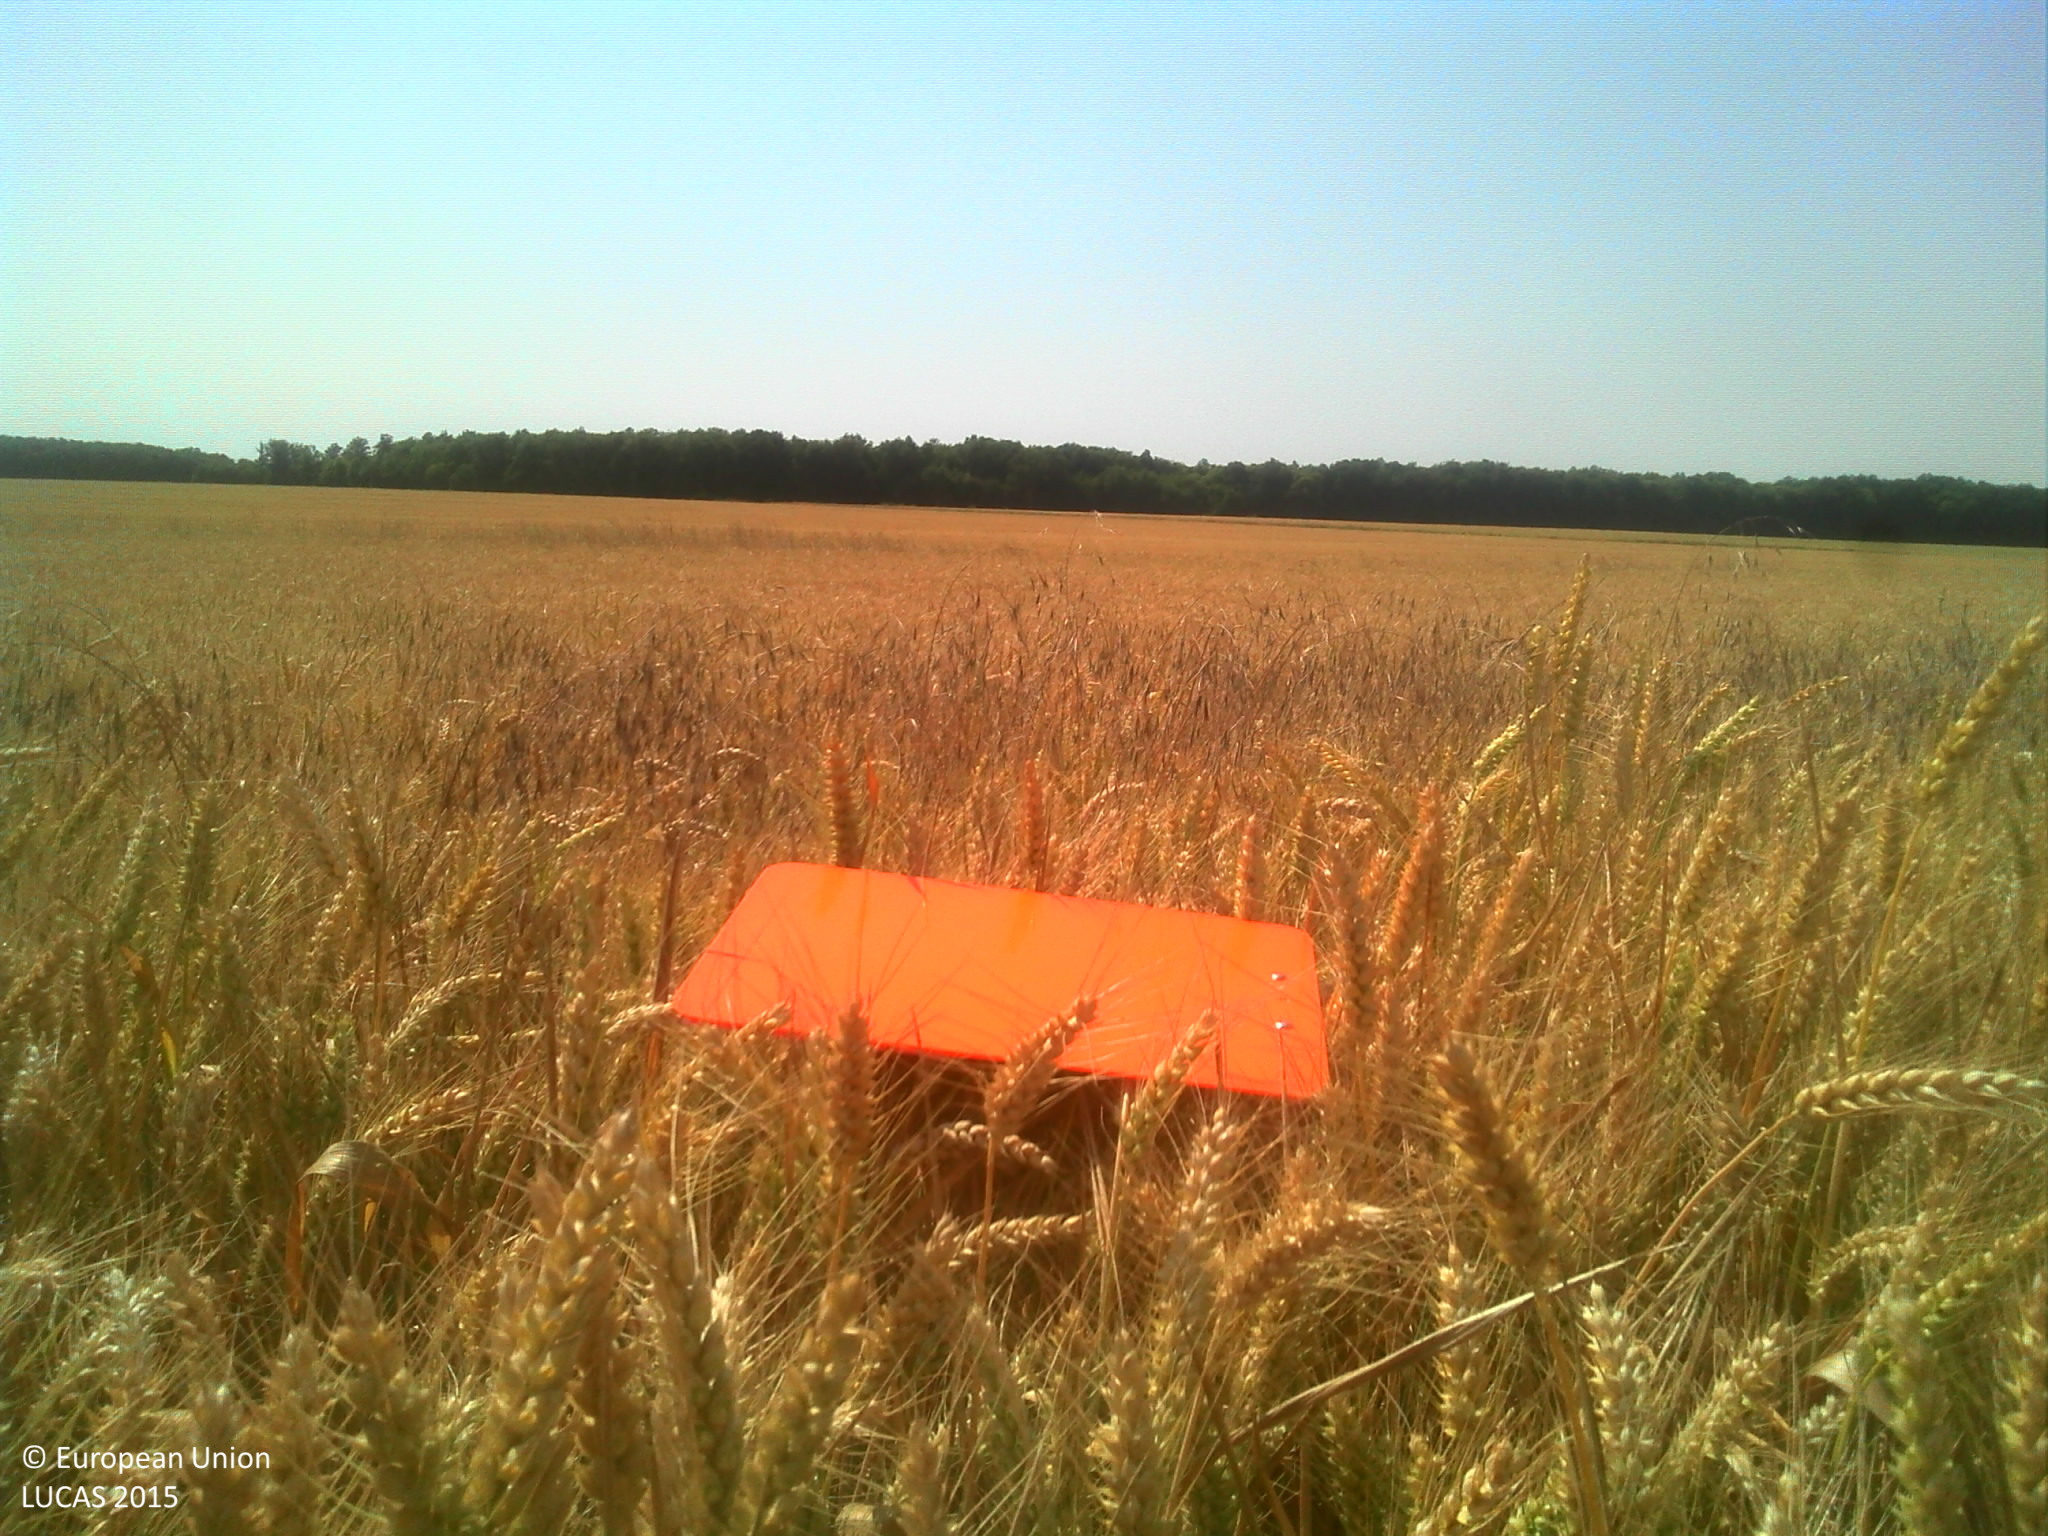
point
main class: Cropland
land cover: Common wheat
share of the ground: > 75 %
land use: Agriculture (excluding fallow land and kitchen gardens)
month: July
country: FR
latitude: 48.7563
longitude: 1.1795
